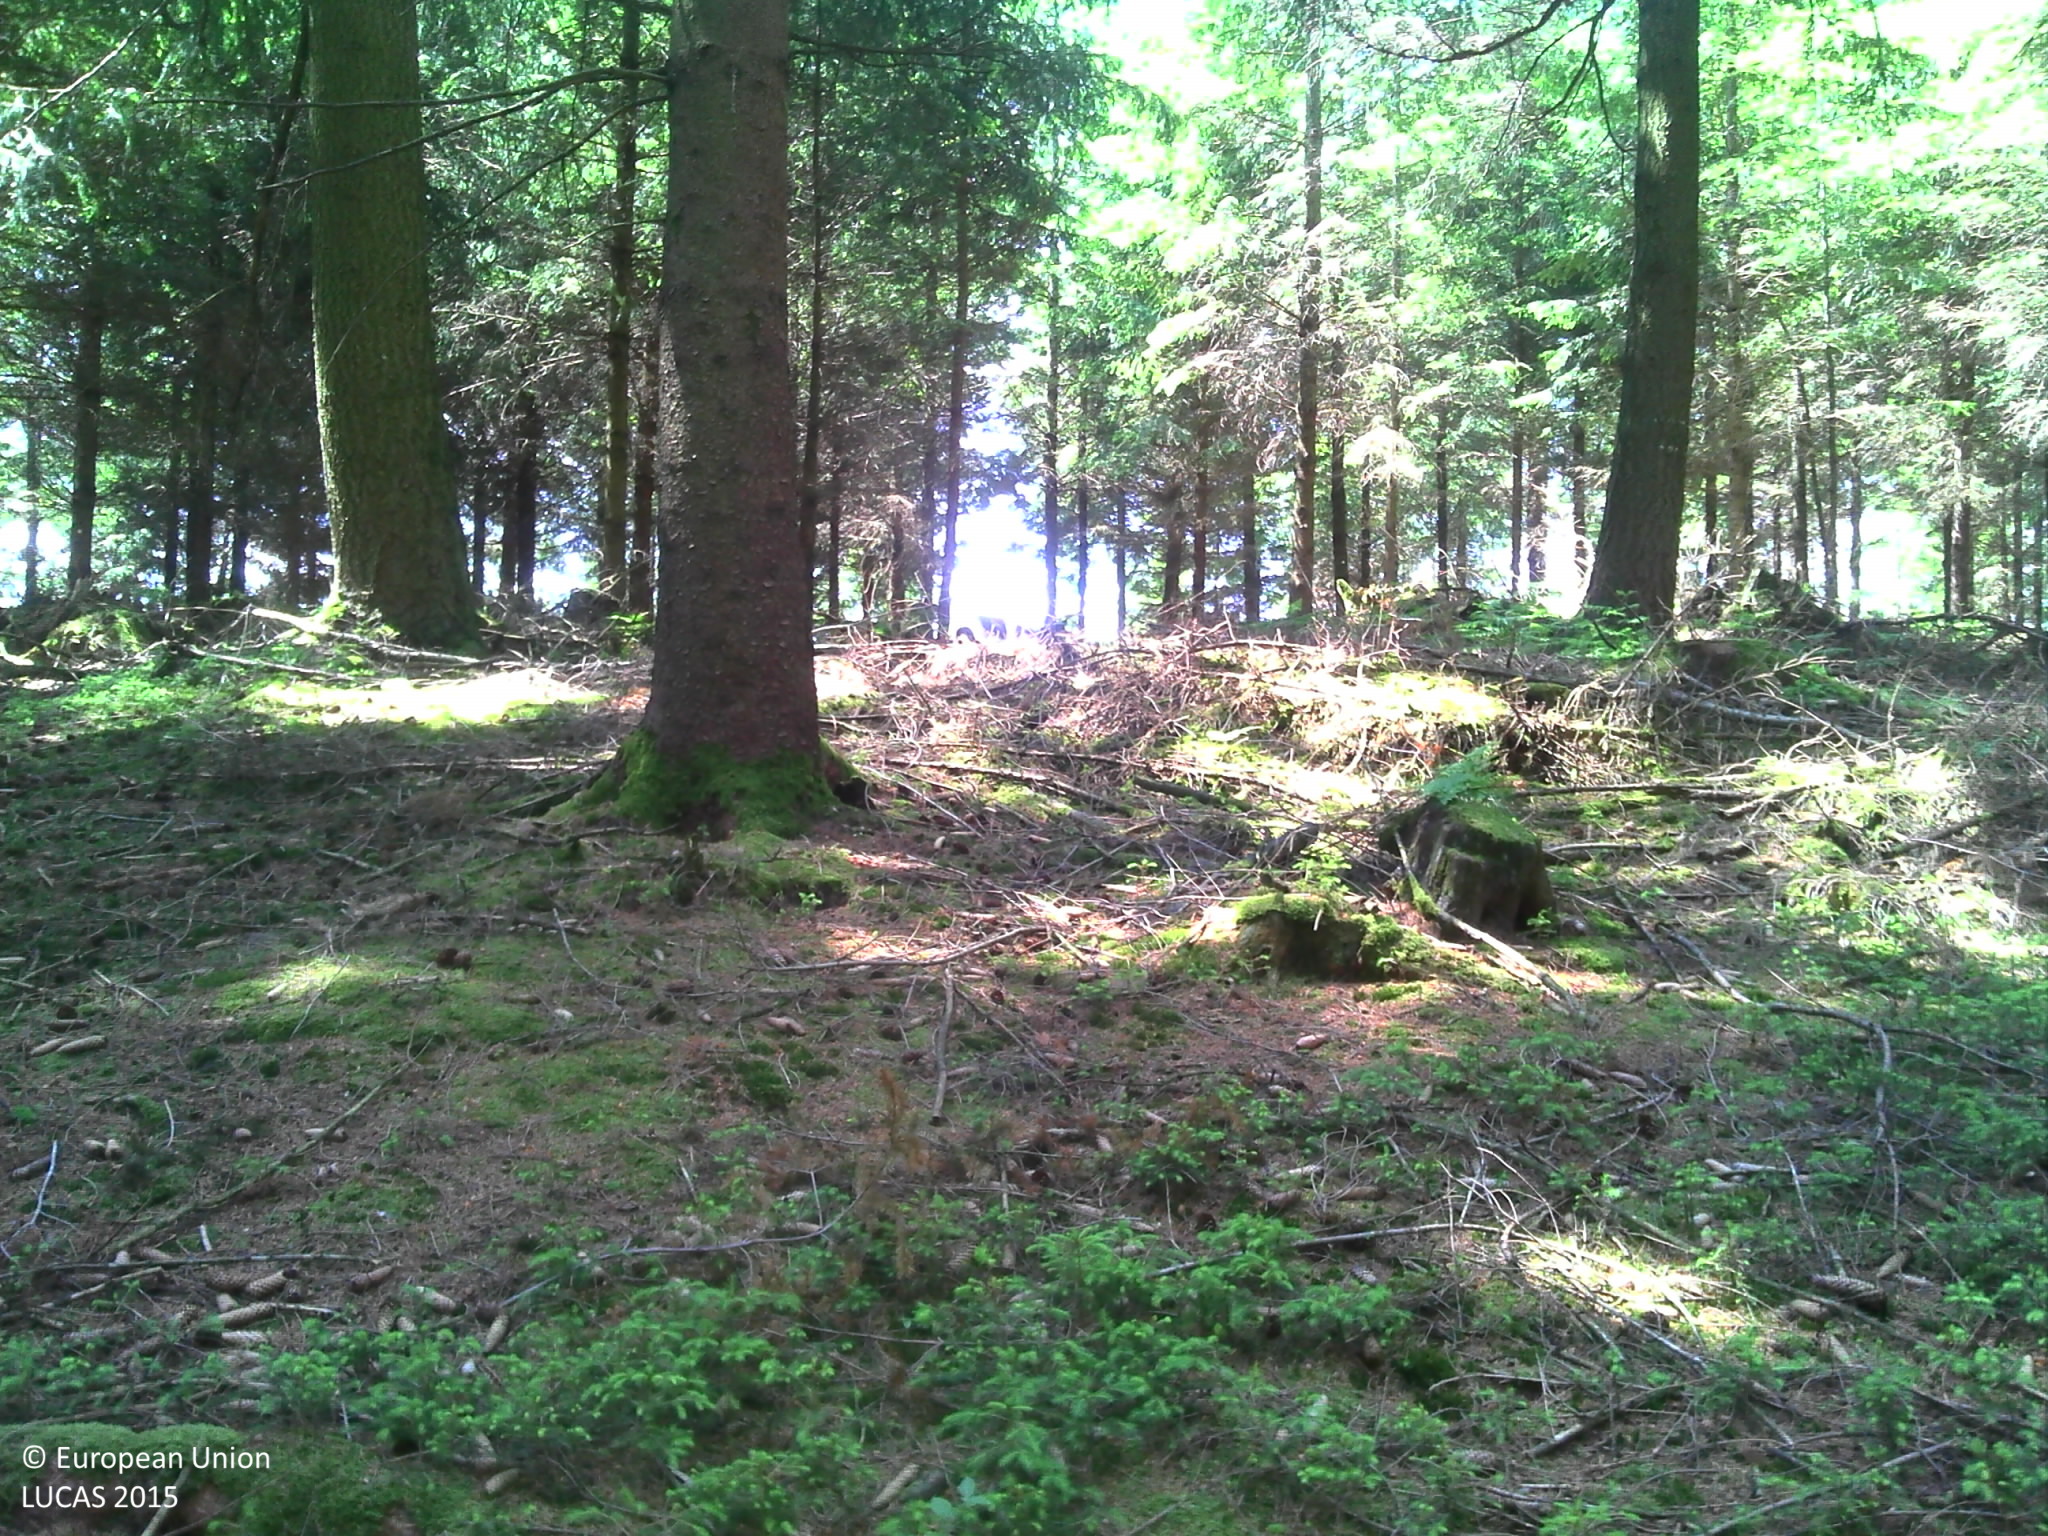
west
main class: Woodland
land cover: Spruce dominated coniferous woodland
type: alpine coniferous forest
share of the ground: > 75 %
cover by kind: coniferous forest trees 95 %, unconsolidated bare surface 5 %
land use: Forestry
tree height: > 5 m
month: June
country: BE
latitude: 49.9815
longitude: 4.5433
